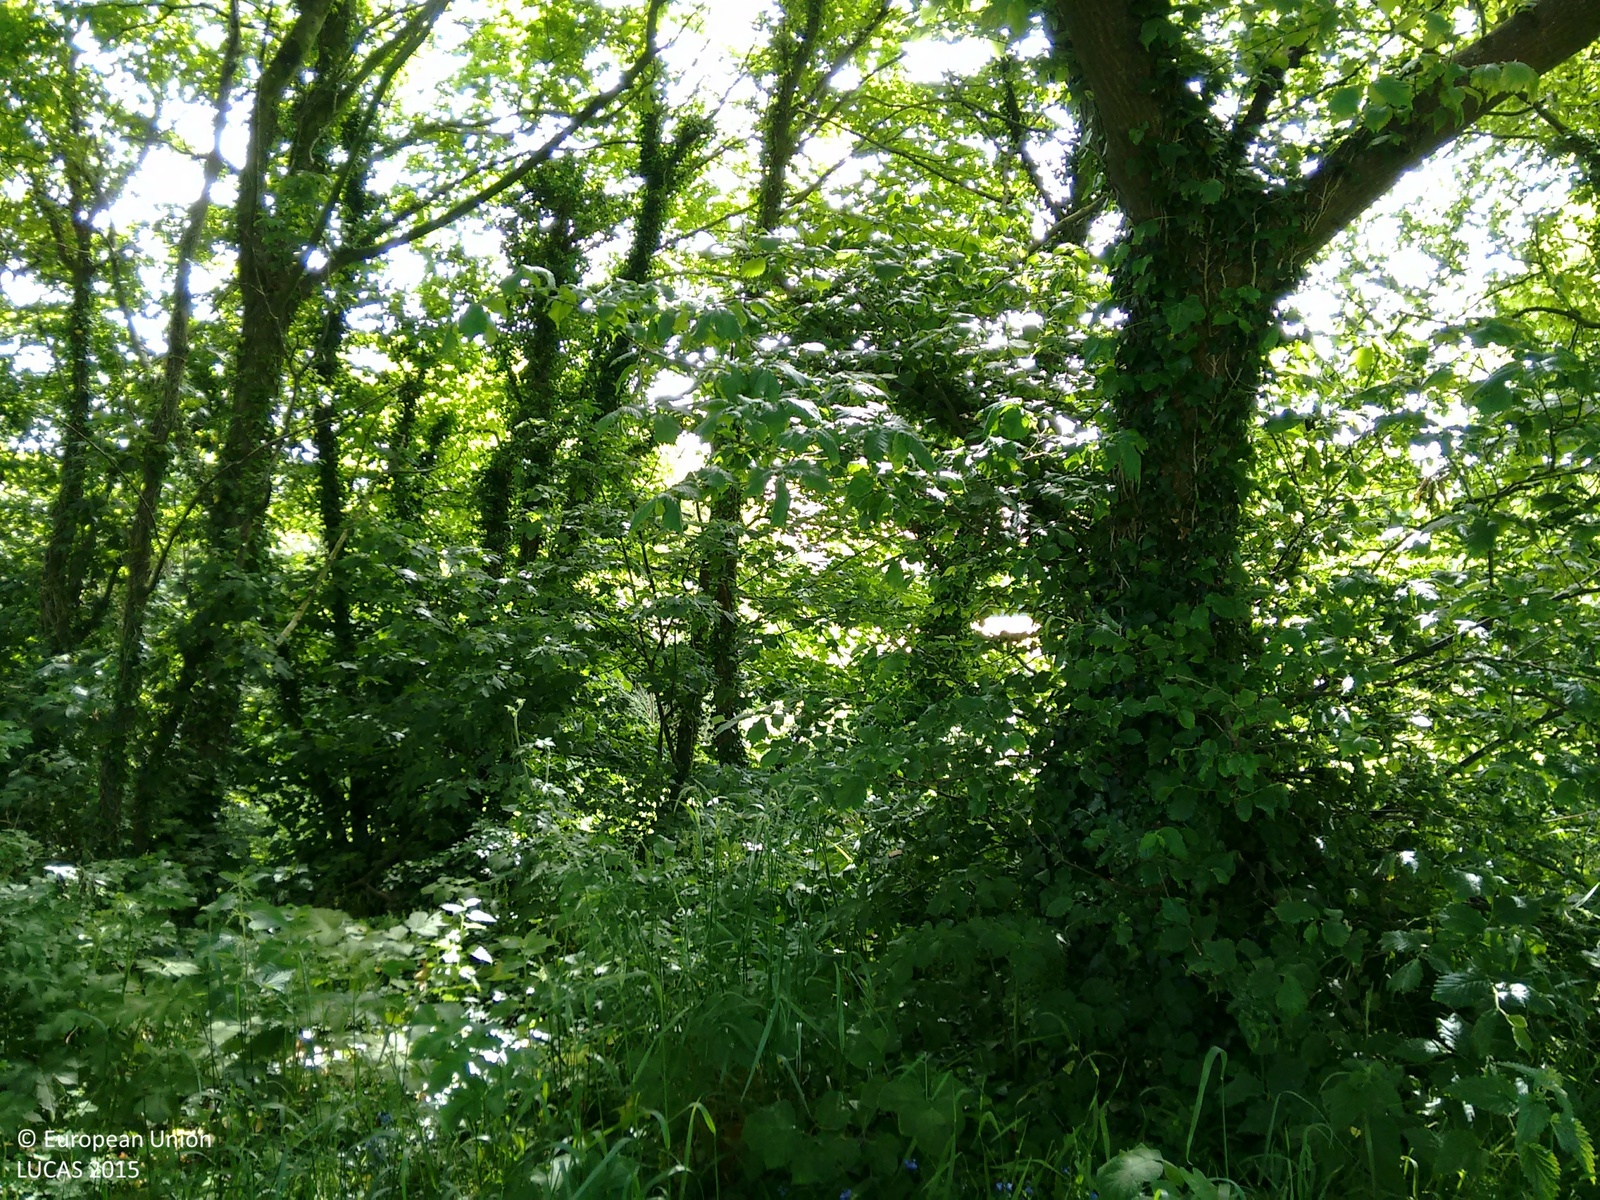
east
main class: Woodland
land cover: Broadleaved woodland
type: acidophilous oak and oak-birch forest
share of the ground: > 75 %
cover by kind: broadleaved forest trees 95 %, shrubs 5 %
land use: Semi-natural and natural areas not in use
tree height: > 5 m
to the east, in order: Broadleaved woodland; Artificial constructions in urban areas; Grassland without tree/shrub cover; Fences; Tracks; Fences; Grassland without tree/shrub cover; Artificial constructions in urban areas; Grassland without tree/shrub cover; Fences; Abandoned hedges; Paved roads, cycling and walking lanes; Electric lines; Abandoned hedges; Maize
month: June
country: IE
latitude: 52.1655
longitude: -7.3924
